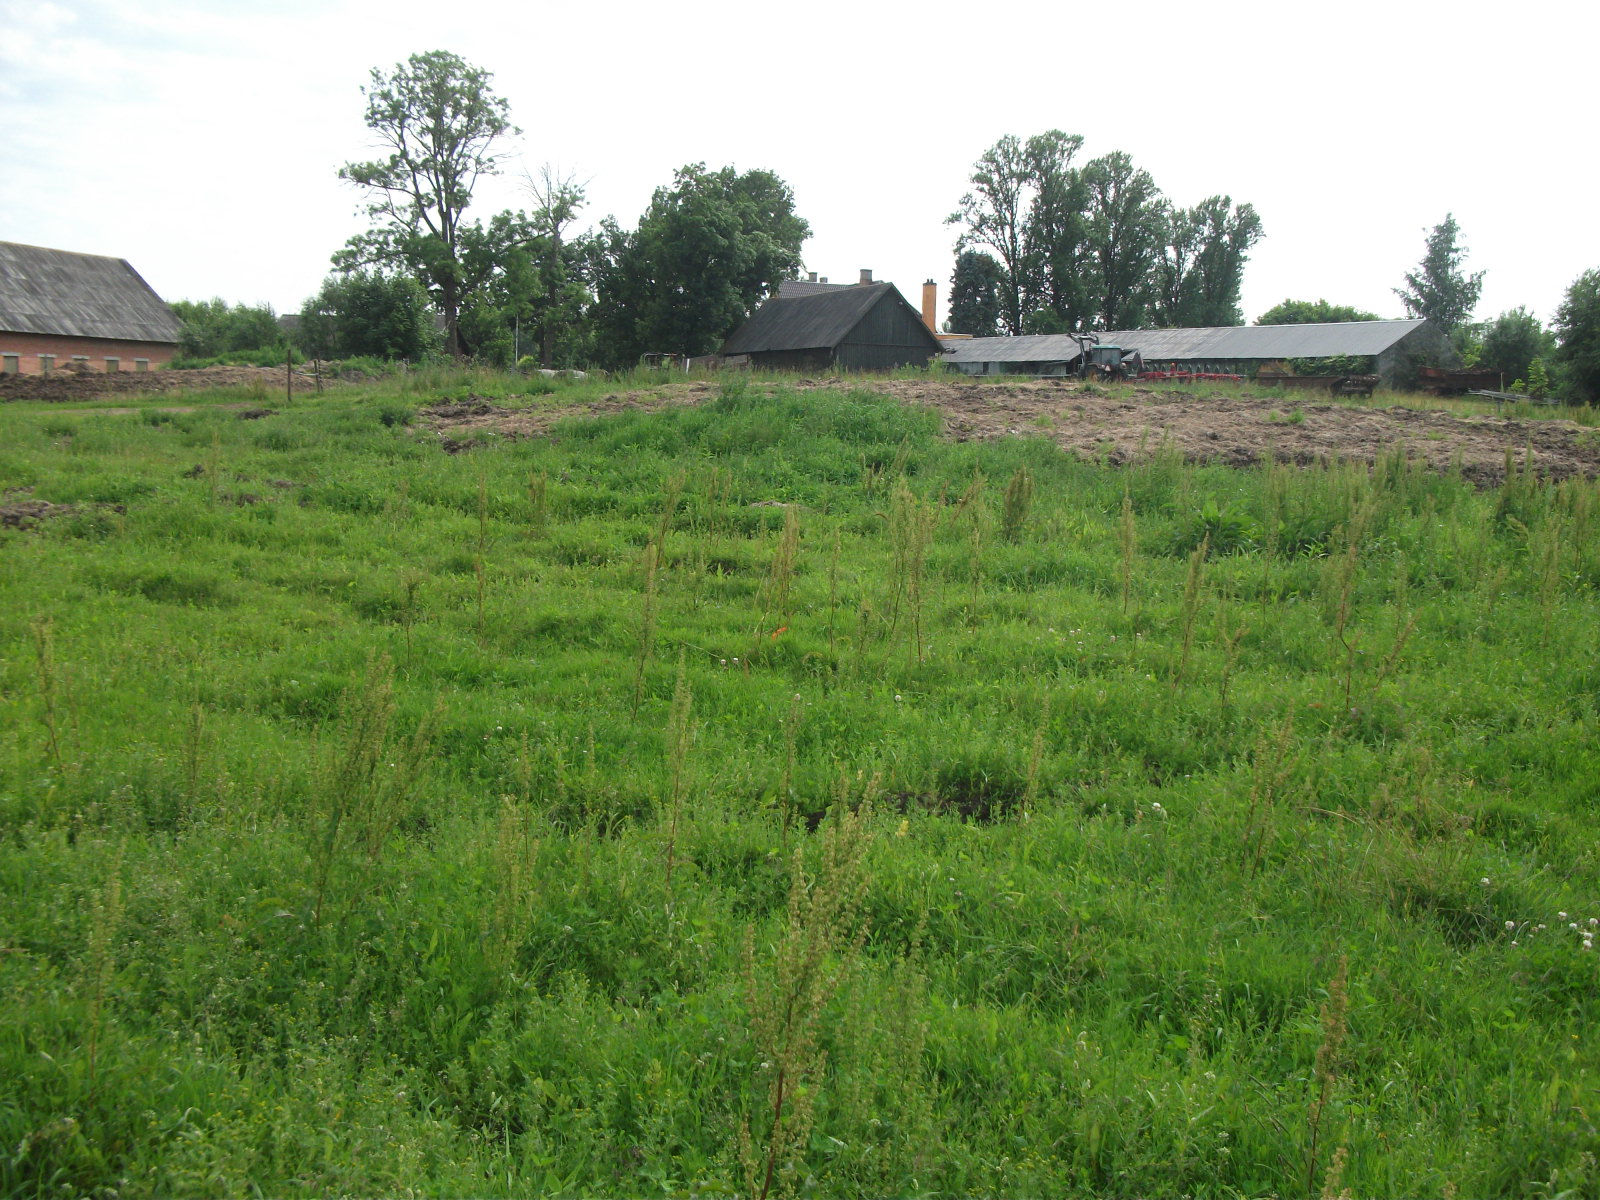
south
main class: Grassland
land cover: Grassland without tree/shrub cover
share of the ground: > 75 %
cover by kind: herbaceous plants 100 %
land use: Agriculture (excluding fallow land and kitchen gardens)
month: July
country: LV
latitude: 57.1485
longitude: 26.5251
